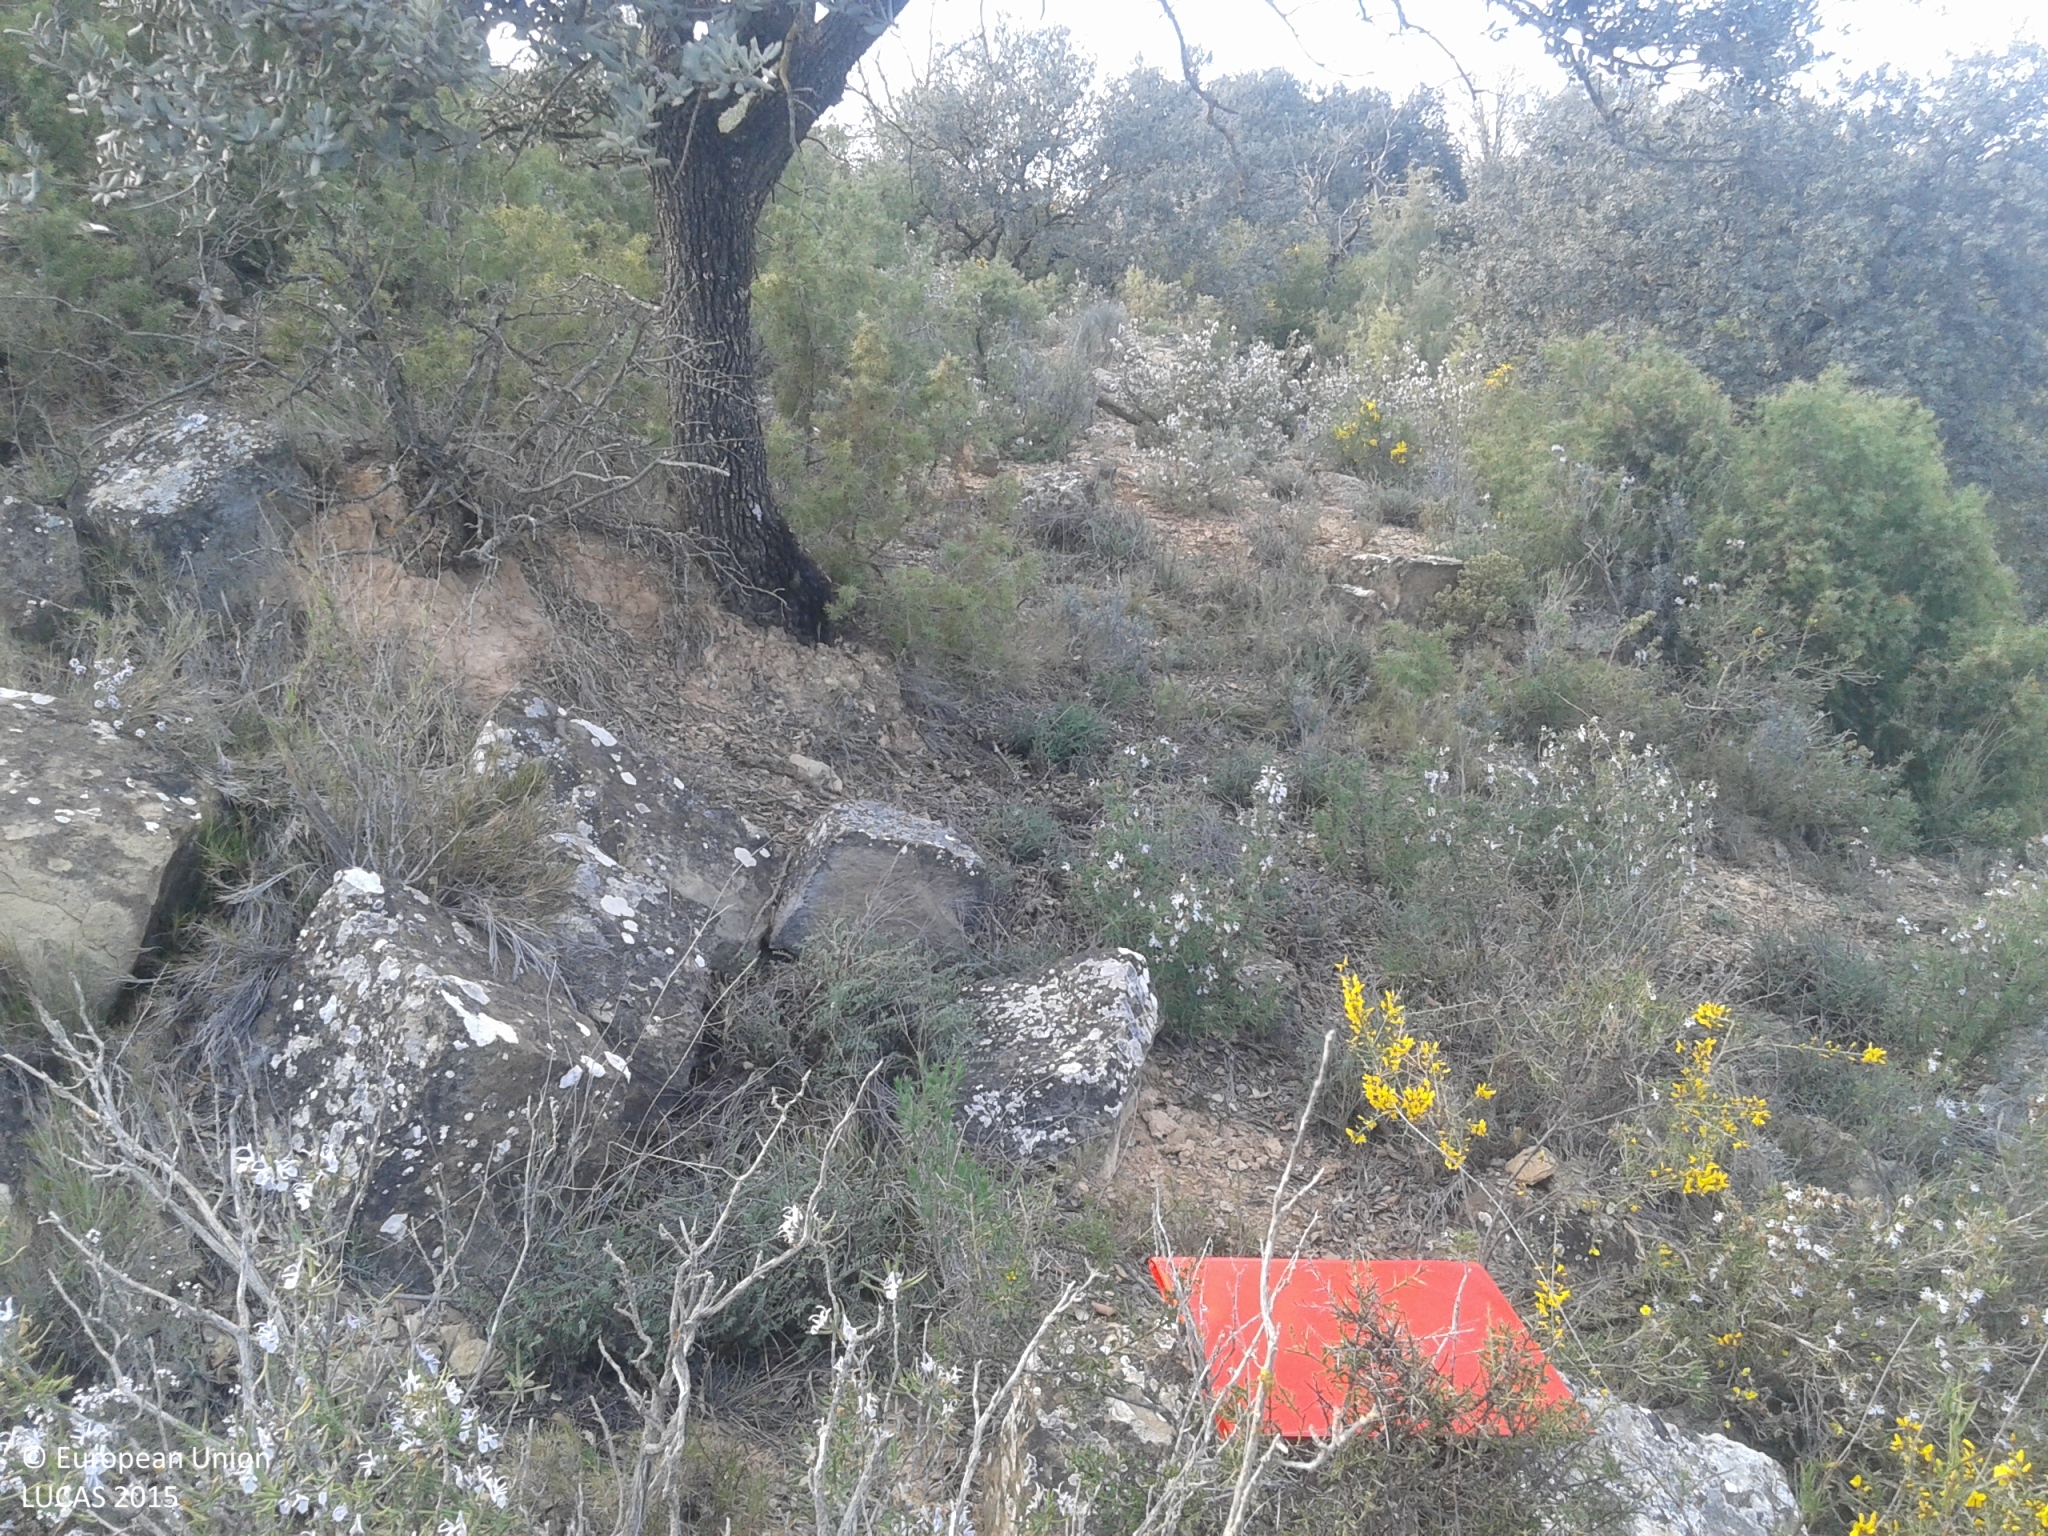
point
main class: Woodland
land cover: Broadleaved woodland
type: broadleaved evergreen forest
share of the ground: > 75 %
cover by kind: shrubs 50 %, broadleaved forest trees 20 %, consolidated bare surface 20 %, herbaceous plants 10 %
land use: Semi-natural and natural areas not in use
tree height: < 5 m
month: April
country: ES
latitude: 41.8248
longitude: 1.0906
